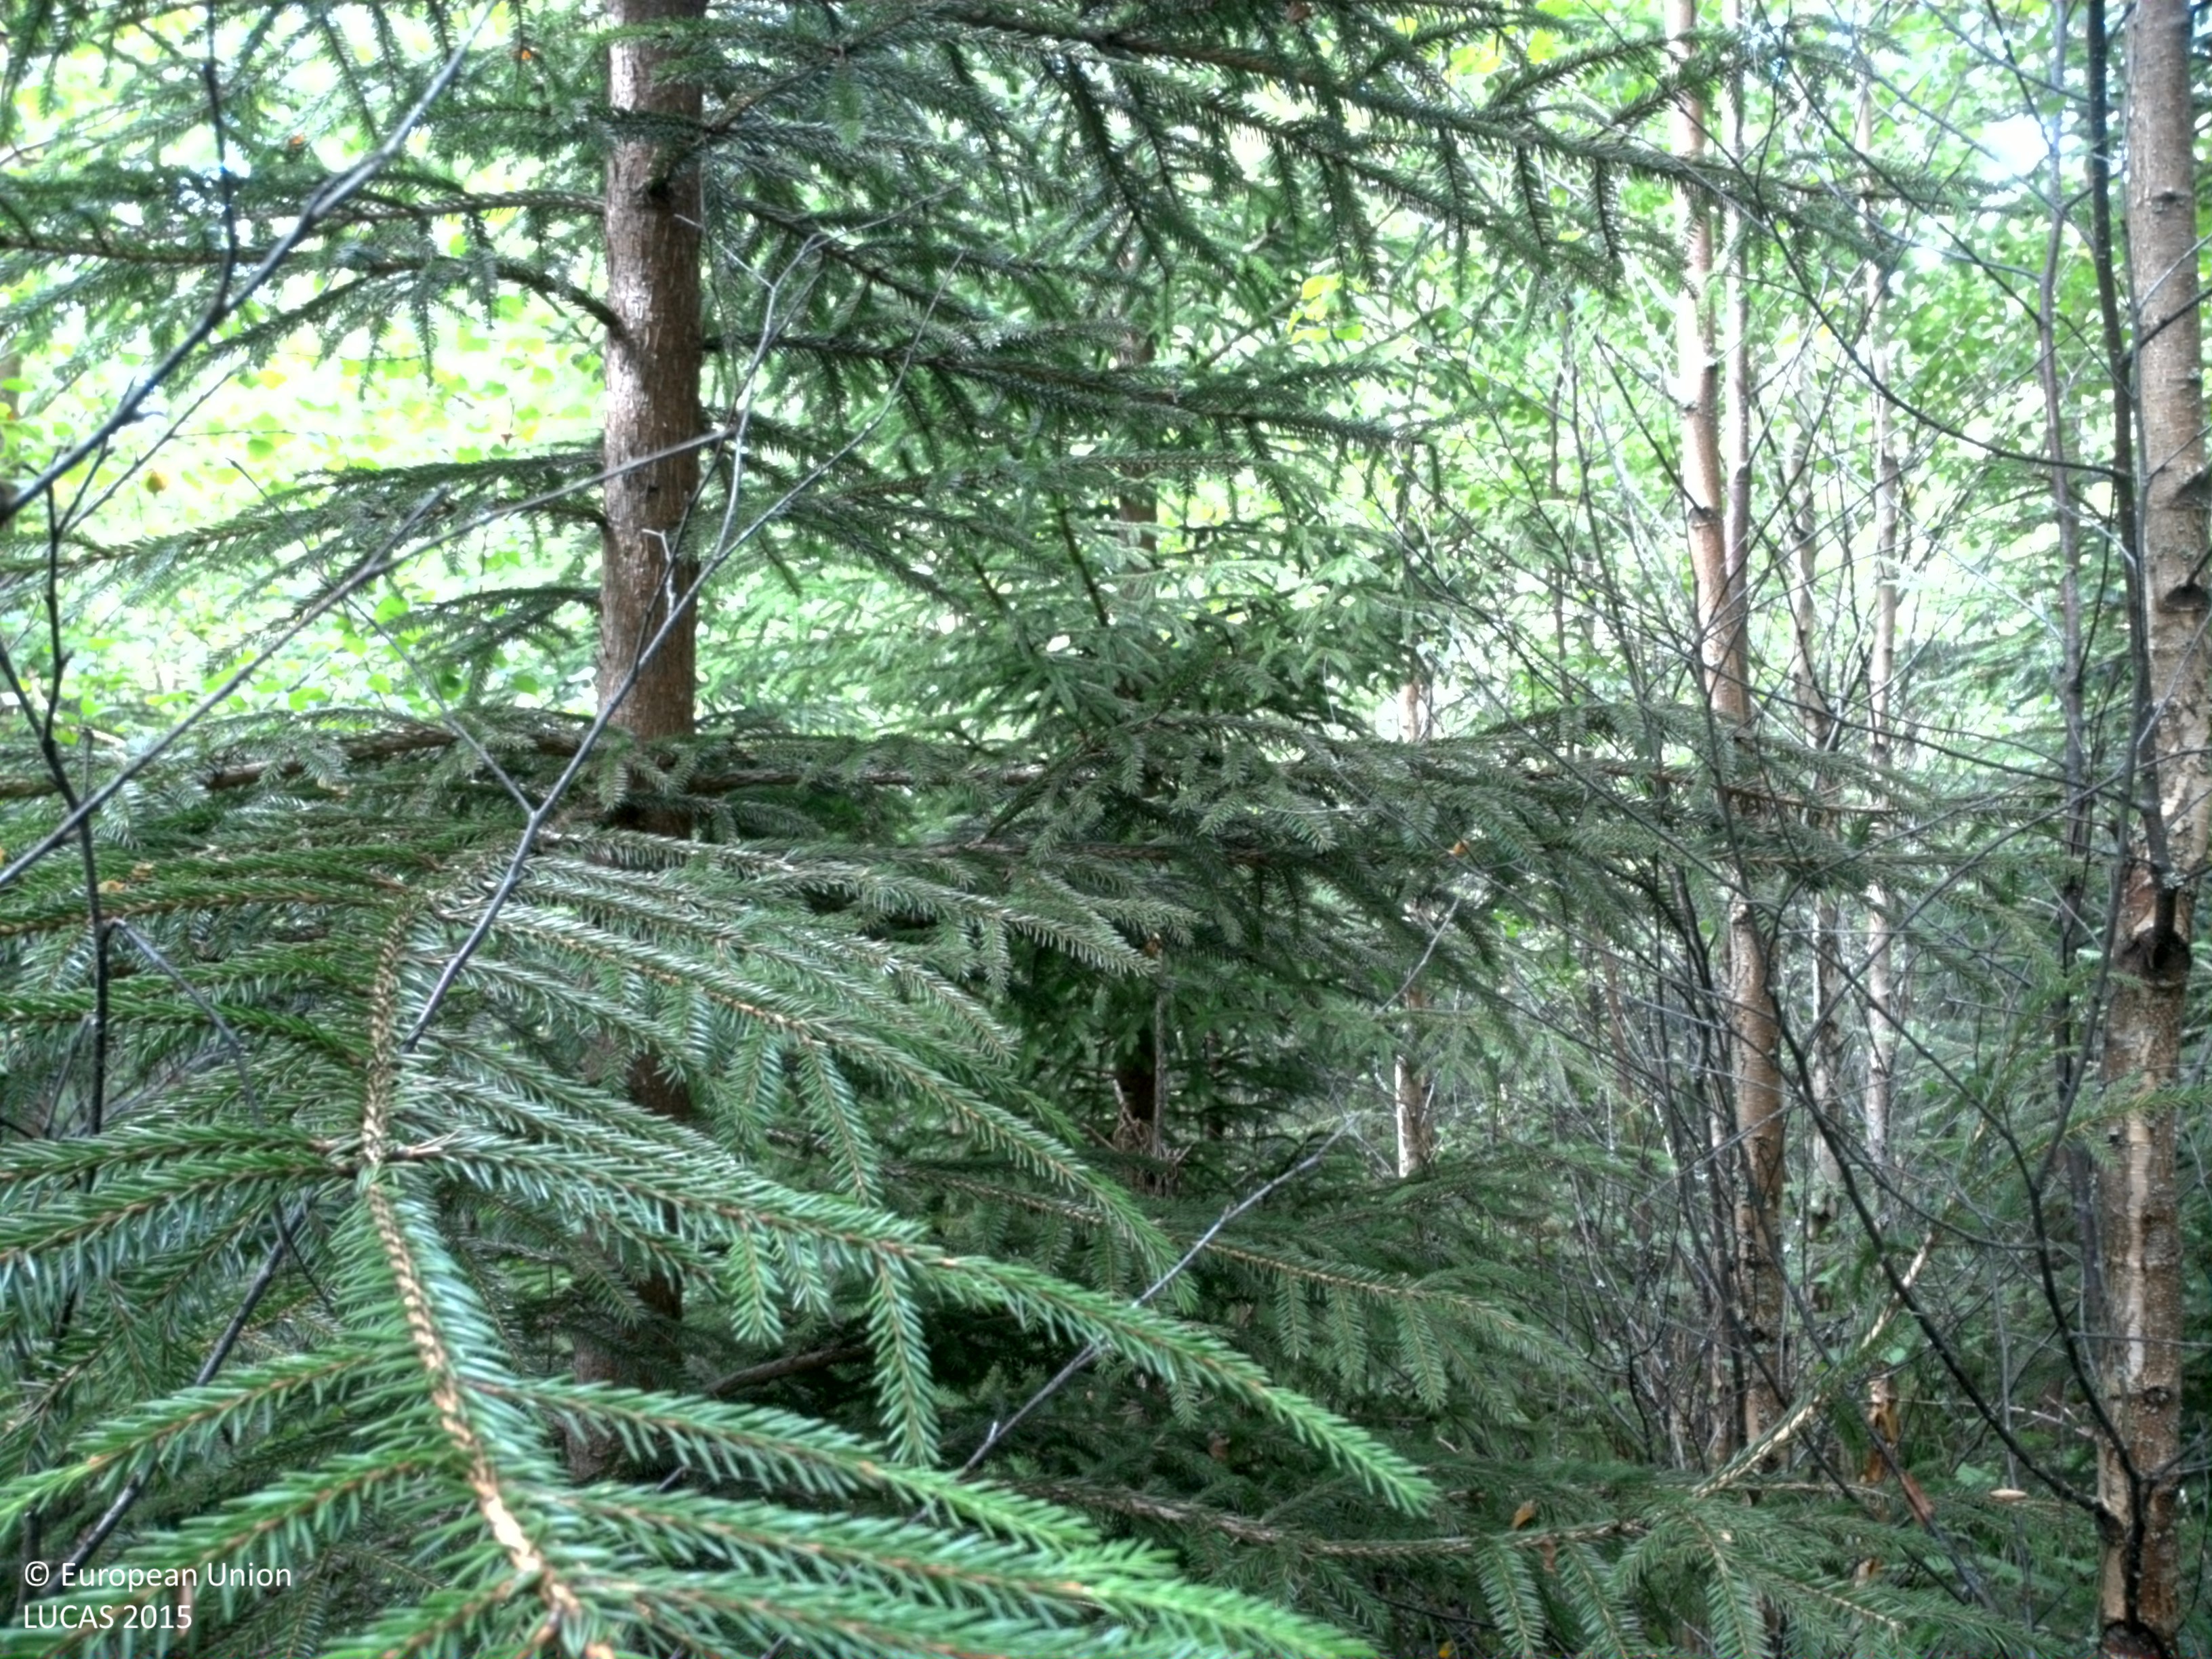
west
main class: Woodland
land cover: Spruce dominated mixed woodland
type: boreal forest
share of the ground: 50 - 75 %
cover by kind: coniferous forest trees 40 %, broadleaved forest trees 25 %, herbaceous plants 20 %, lichens and mosses 10 %, shrubs 5 %
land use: Forestry
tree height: < 5 m
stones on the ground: < 10 %
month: July
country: SE
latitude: 59.4659
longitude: 11.8832
